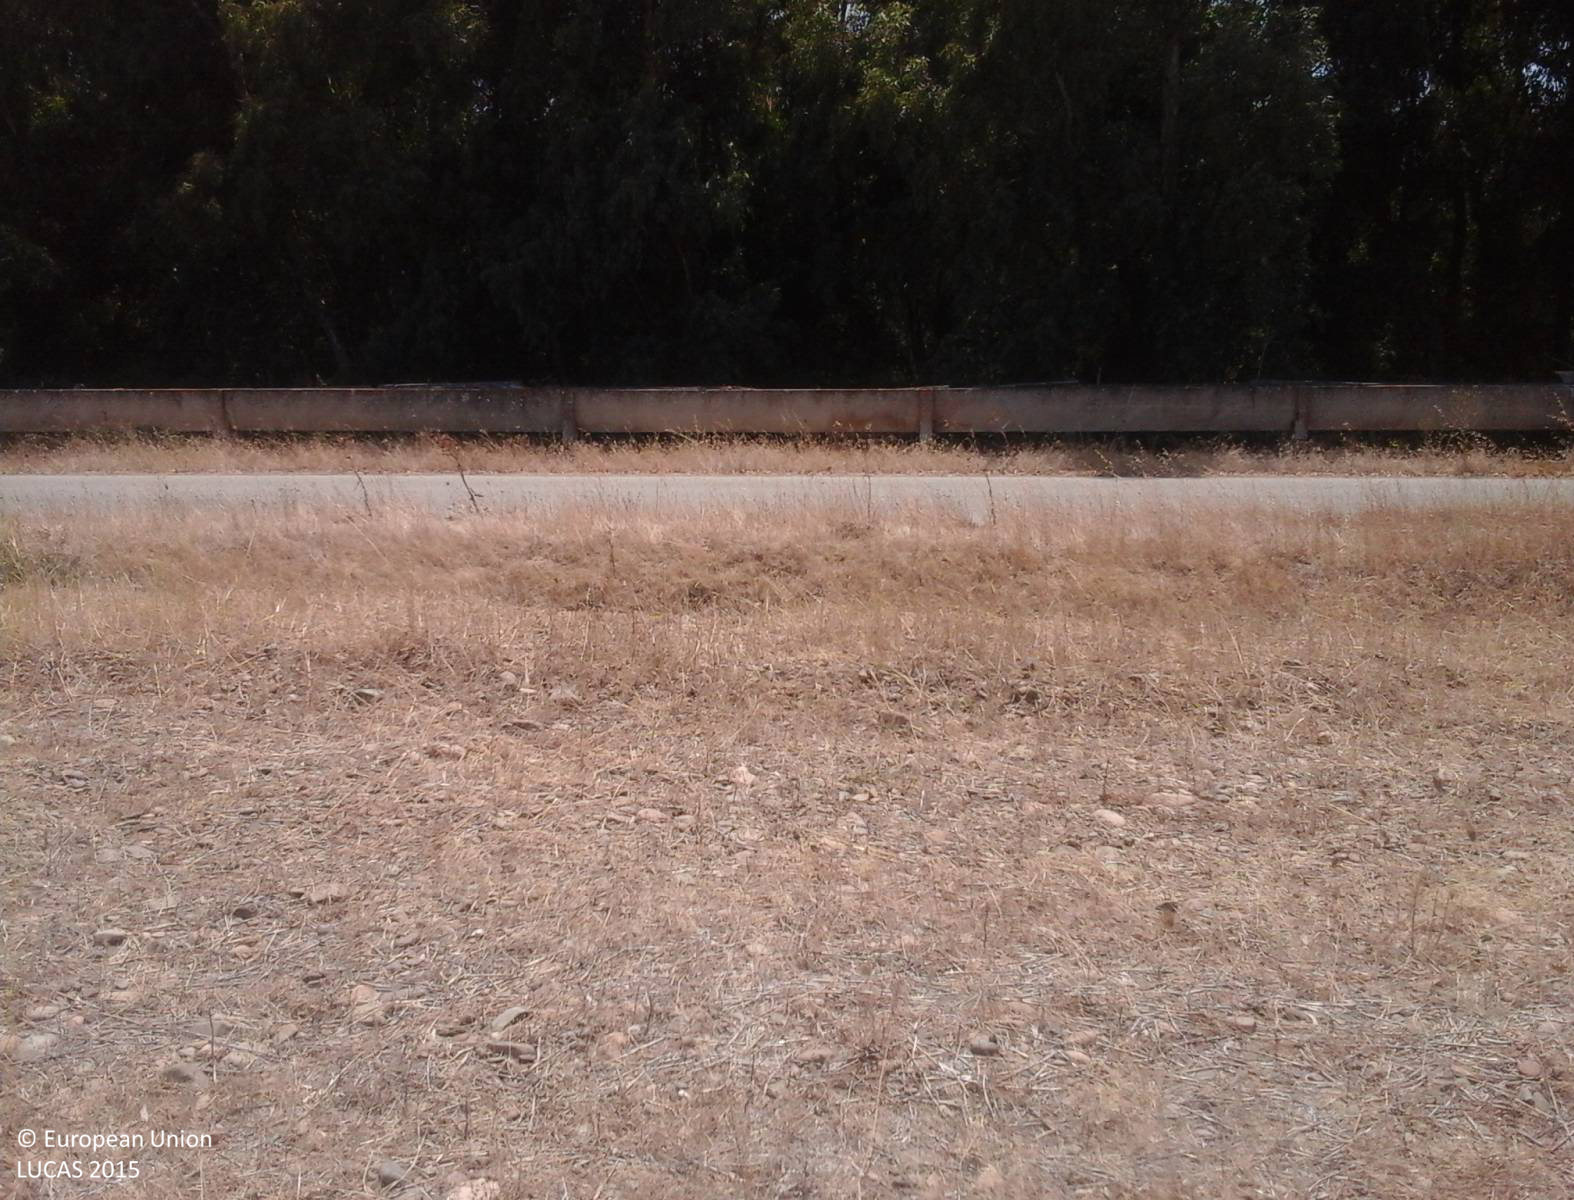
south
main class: Cropland
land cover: Mixed cereals for fodder
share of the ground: > 75 %
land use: Agriculture (excluding fallow land and kitchen gardens)
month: August
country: IT
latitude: 39.4459
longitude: 8.8796
